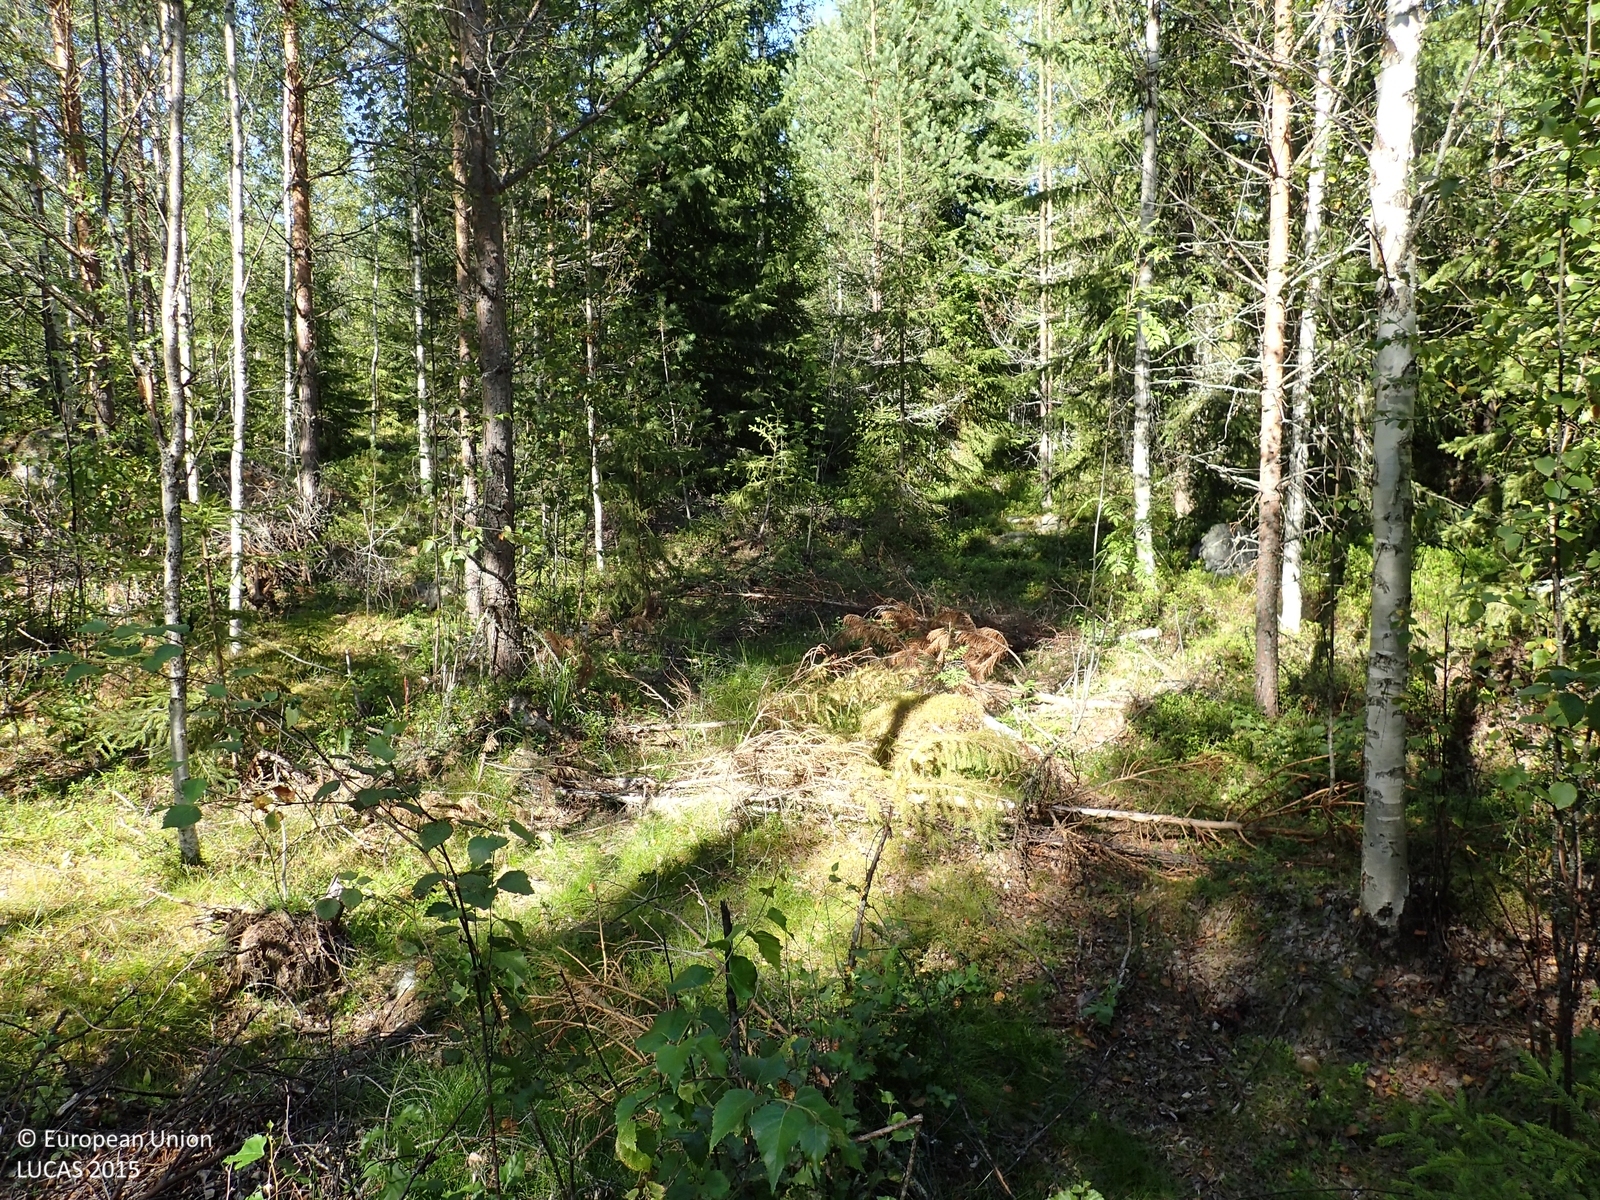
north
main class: Woodland
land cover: Pine dominated mixed woodland
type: boreal forest
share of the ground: > 75 %
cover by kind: broadleaved forest trees 40 %, coniferous forest trees 35 %, shrubs 10 %, herbaceous plants 10 %, lichens and mosses 5 %
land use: Forestry
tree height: > 5 m
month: August
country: FI
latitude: 62.5885
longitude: 22.6544
